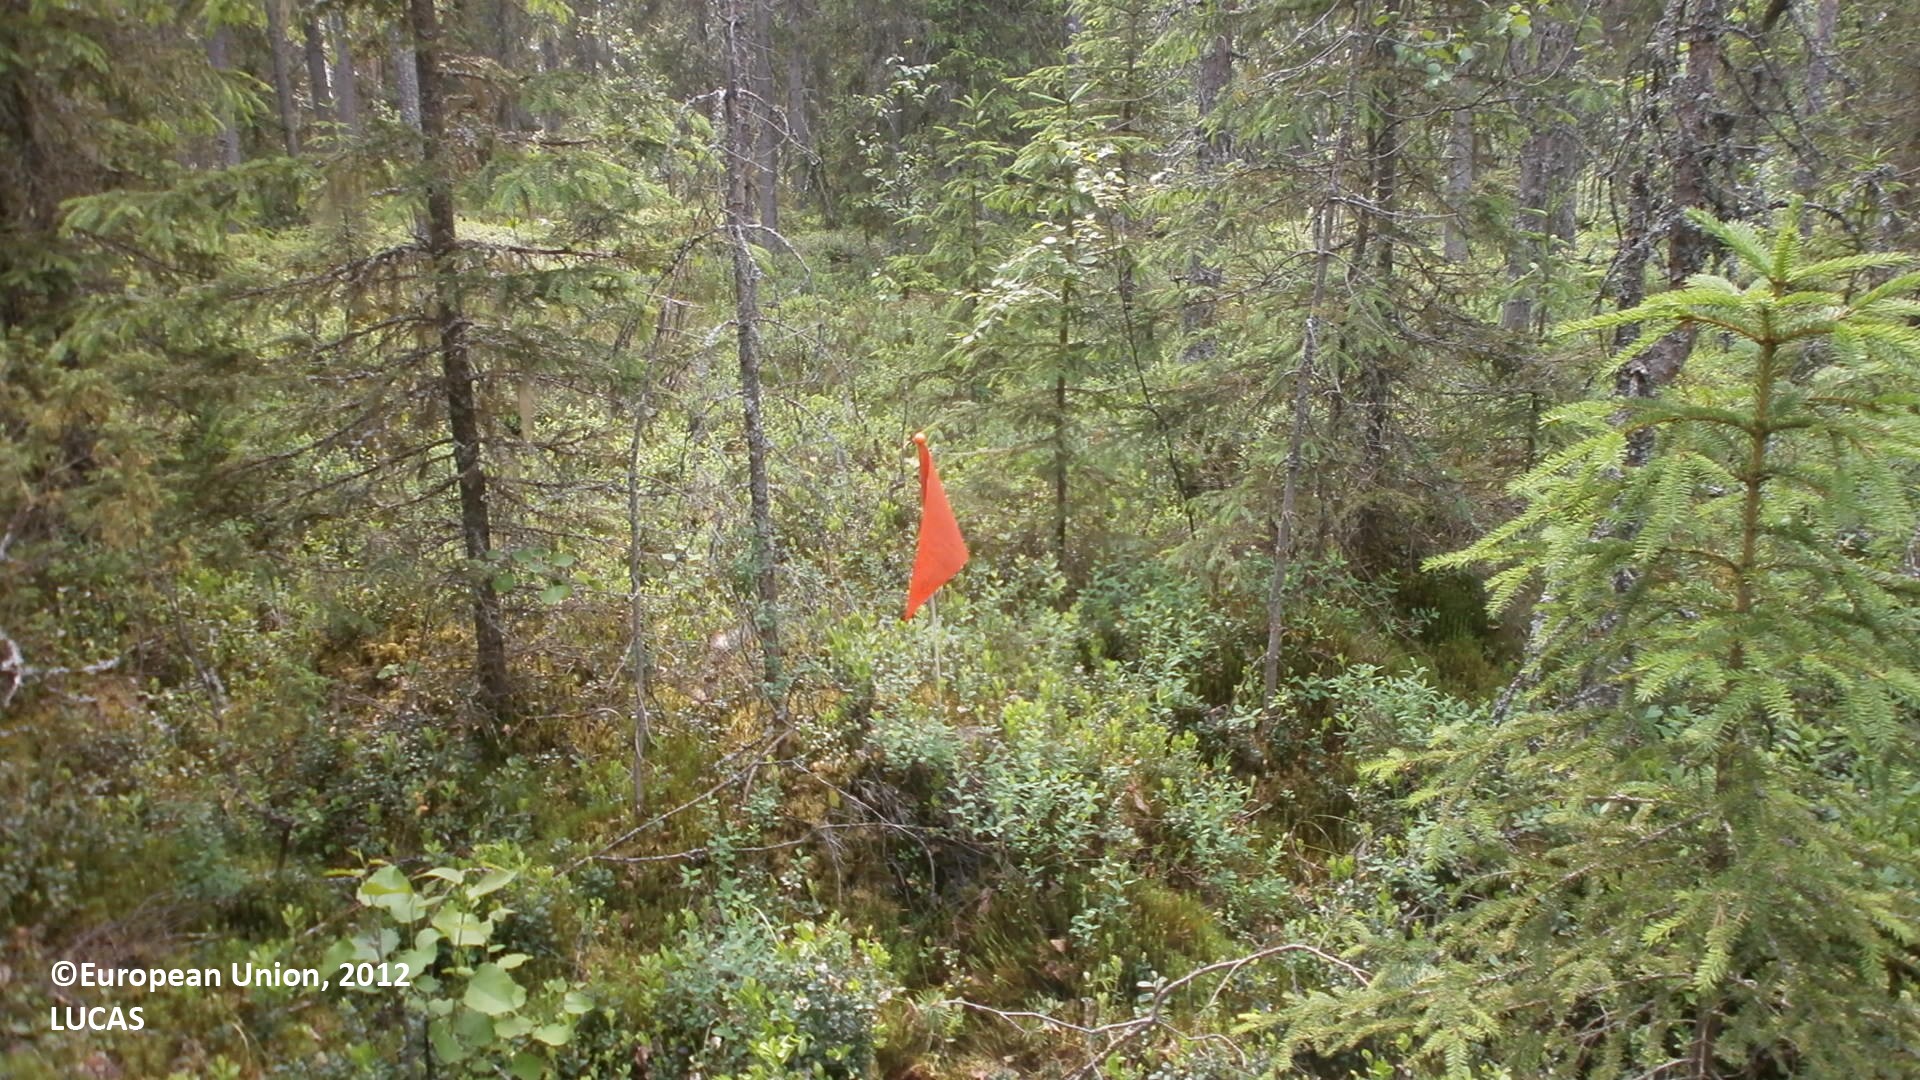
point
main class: Woodland
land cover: Spruce dominated mixed woodland
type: boreal forest
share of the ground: 50 - 75 %
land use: Forestry
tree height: > 5 m
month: July
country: FI
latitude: 64.0486
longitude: 24.8064
